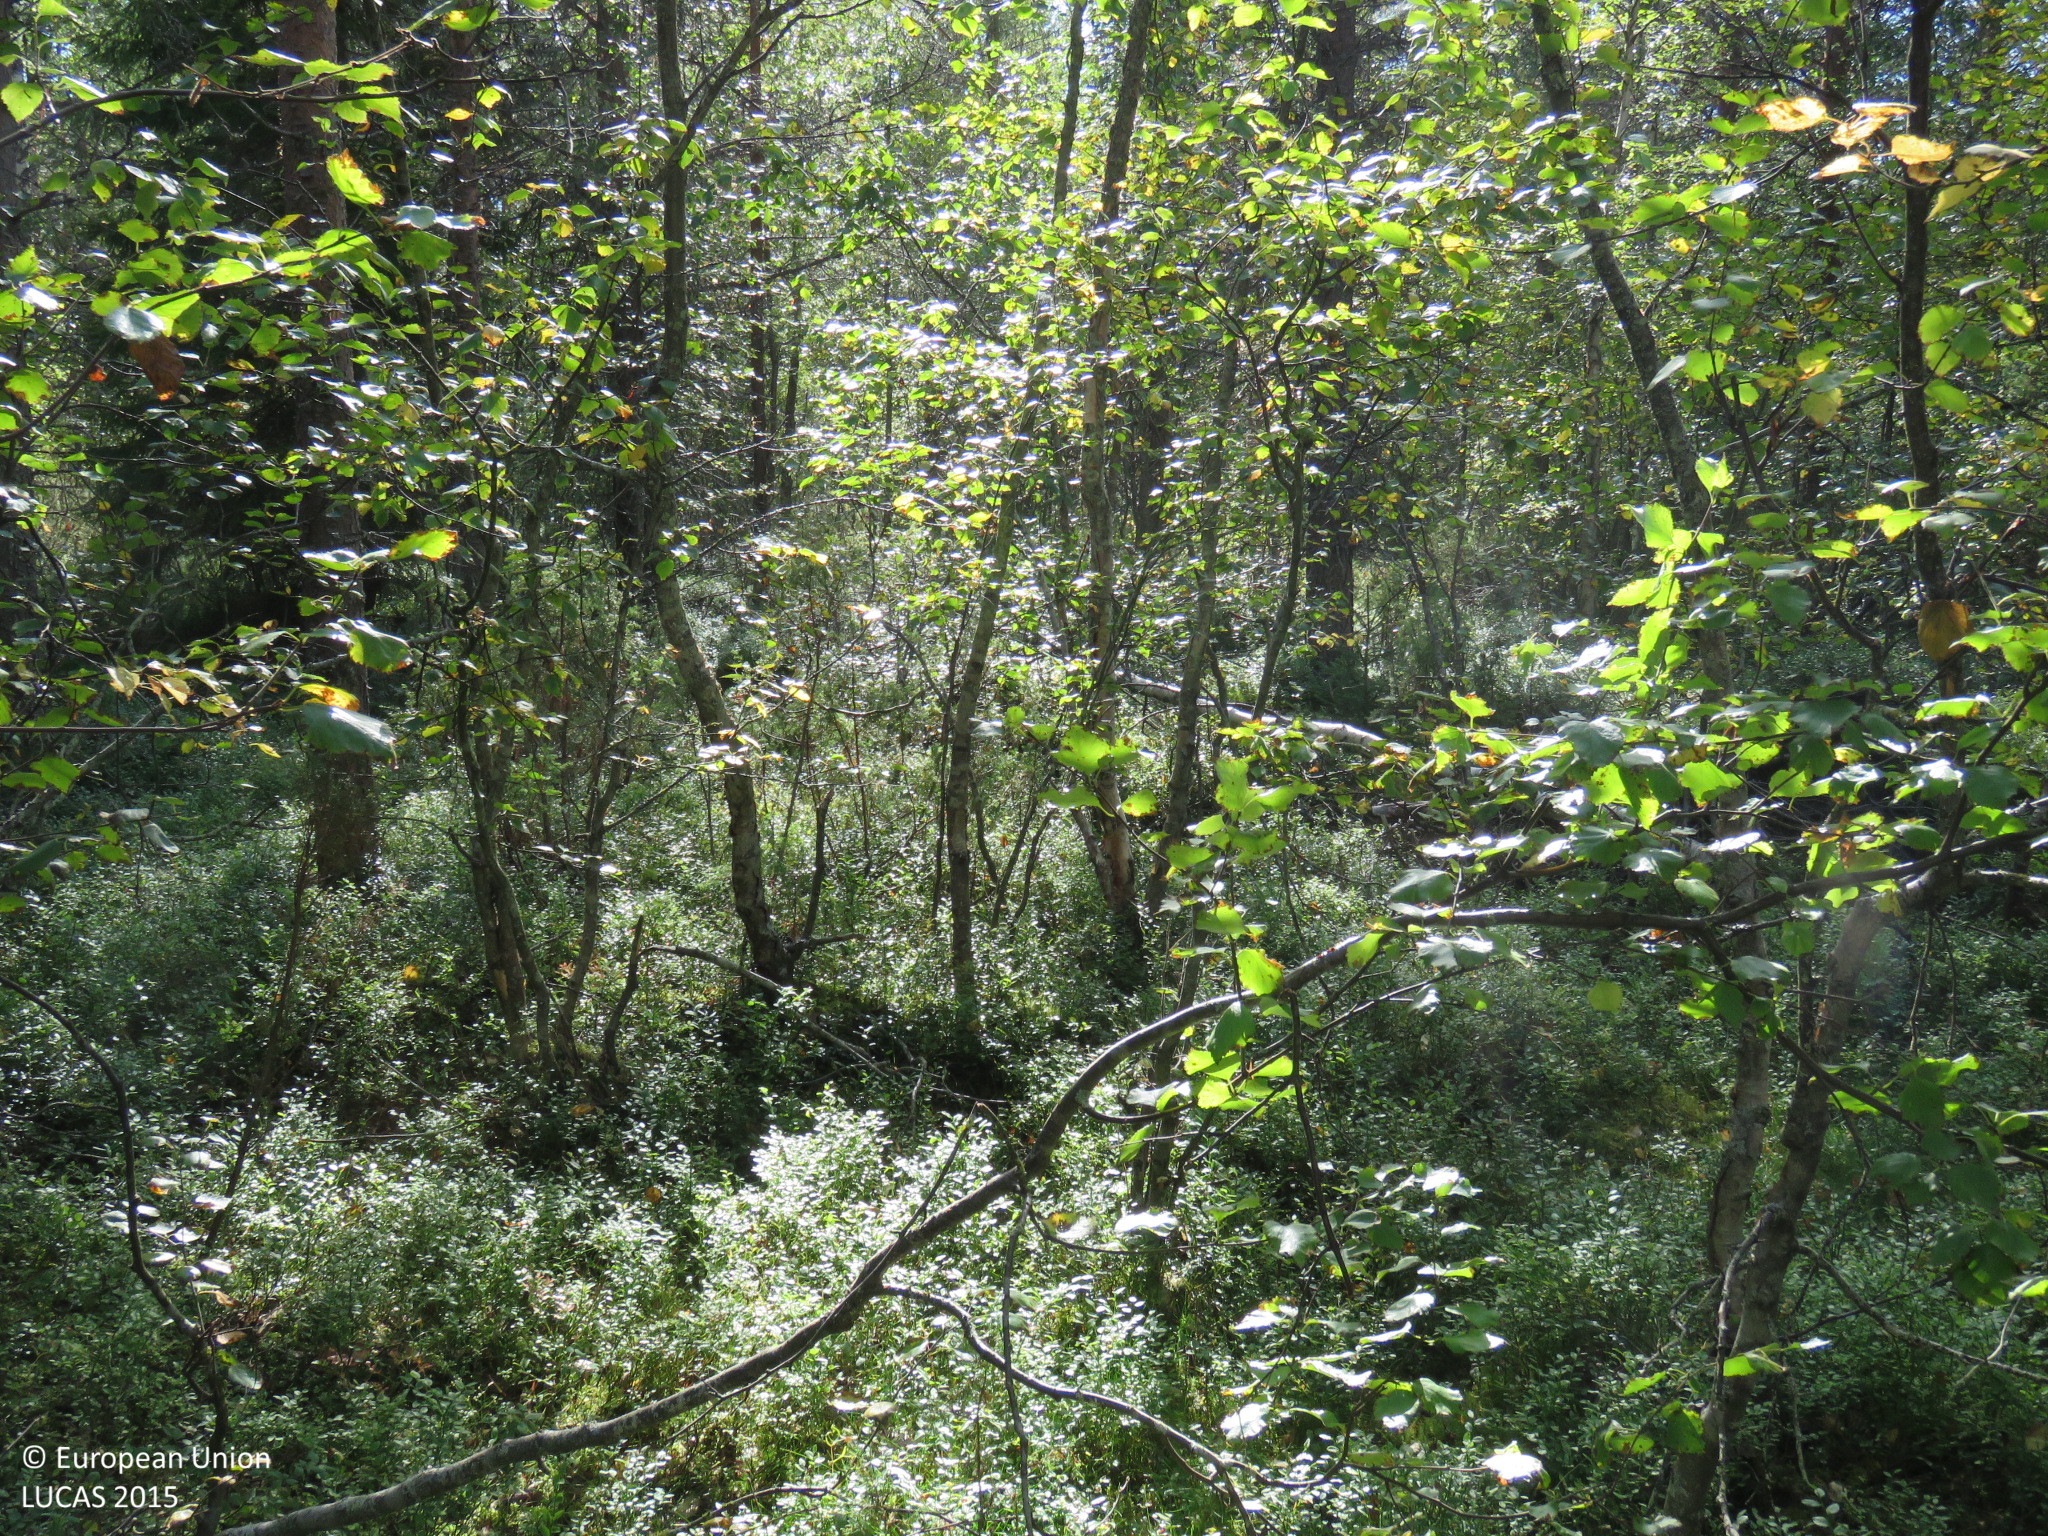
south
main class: Woodland
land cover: Other mixed woodland
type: boreal forest
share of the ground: > 75 %
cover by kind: coniferous forest trees 50 %, broadleaved forest trees 25 %, shrubs 20 %, lichens and mosses 5 %
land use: Forestry
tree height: > 5 m
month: September
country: FI
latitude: 65.4088
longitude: 27.6439
